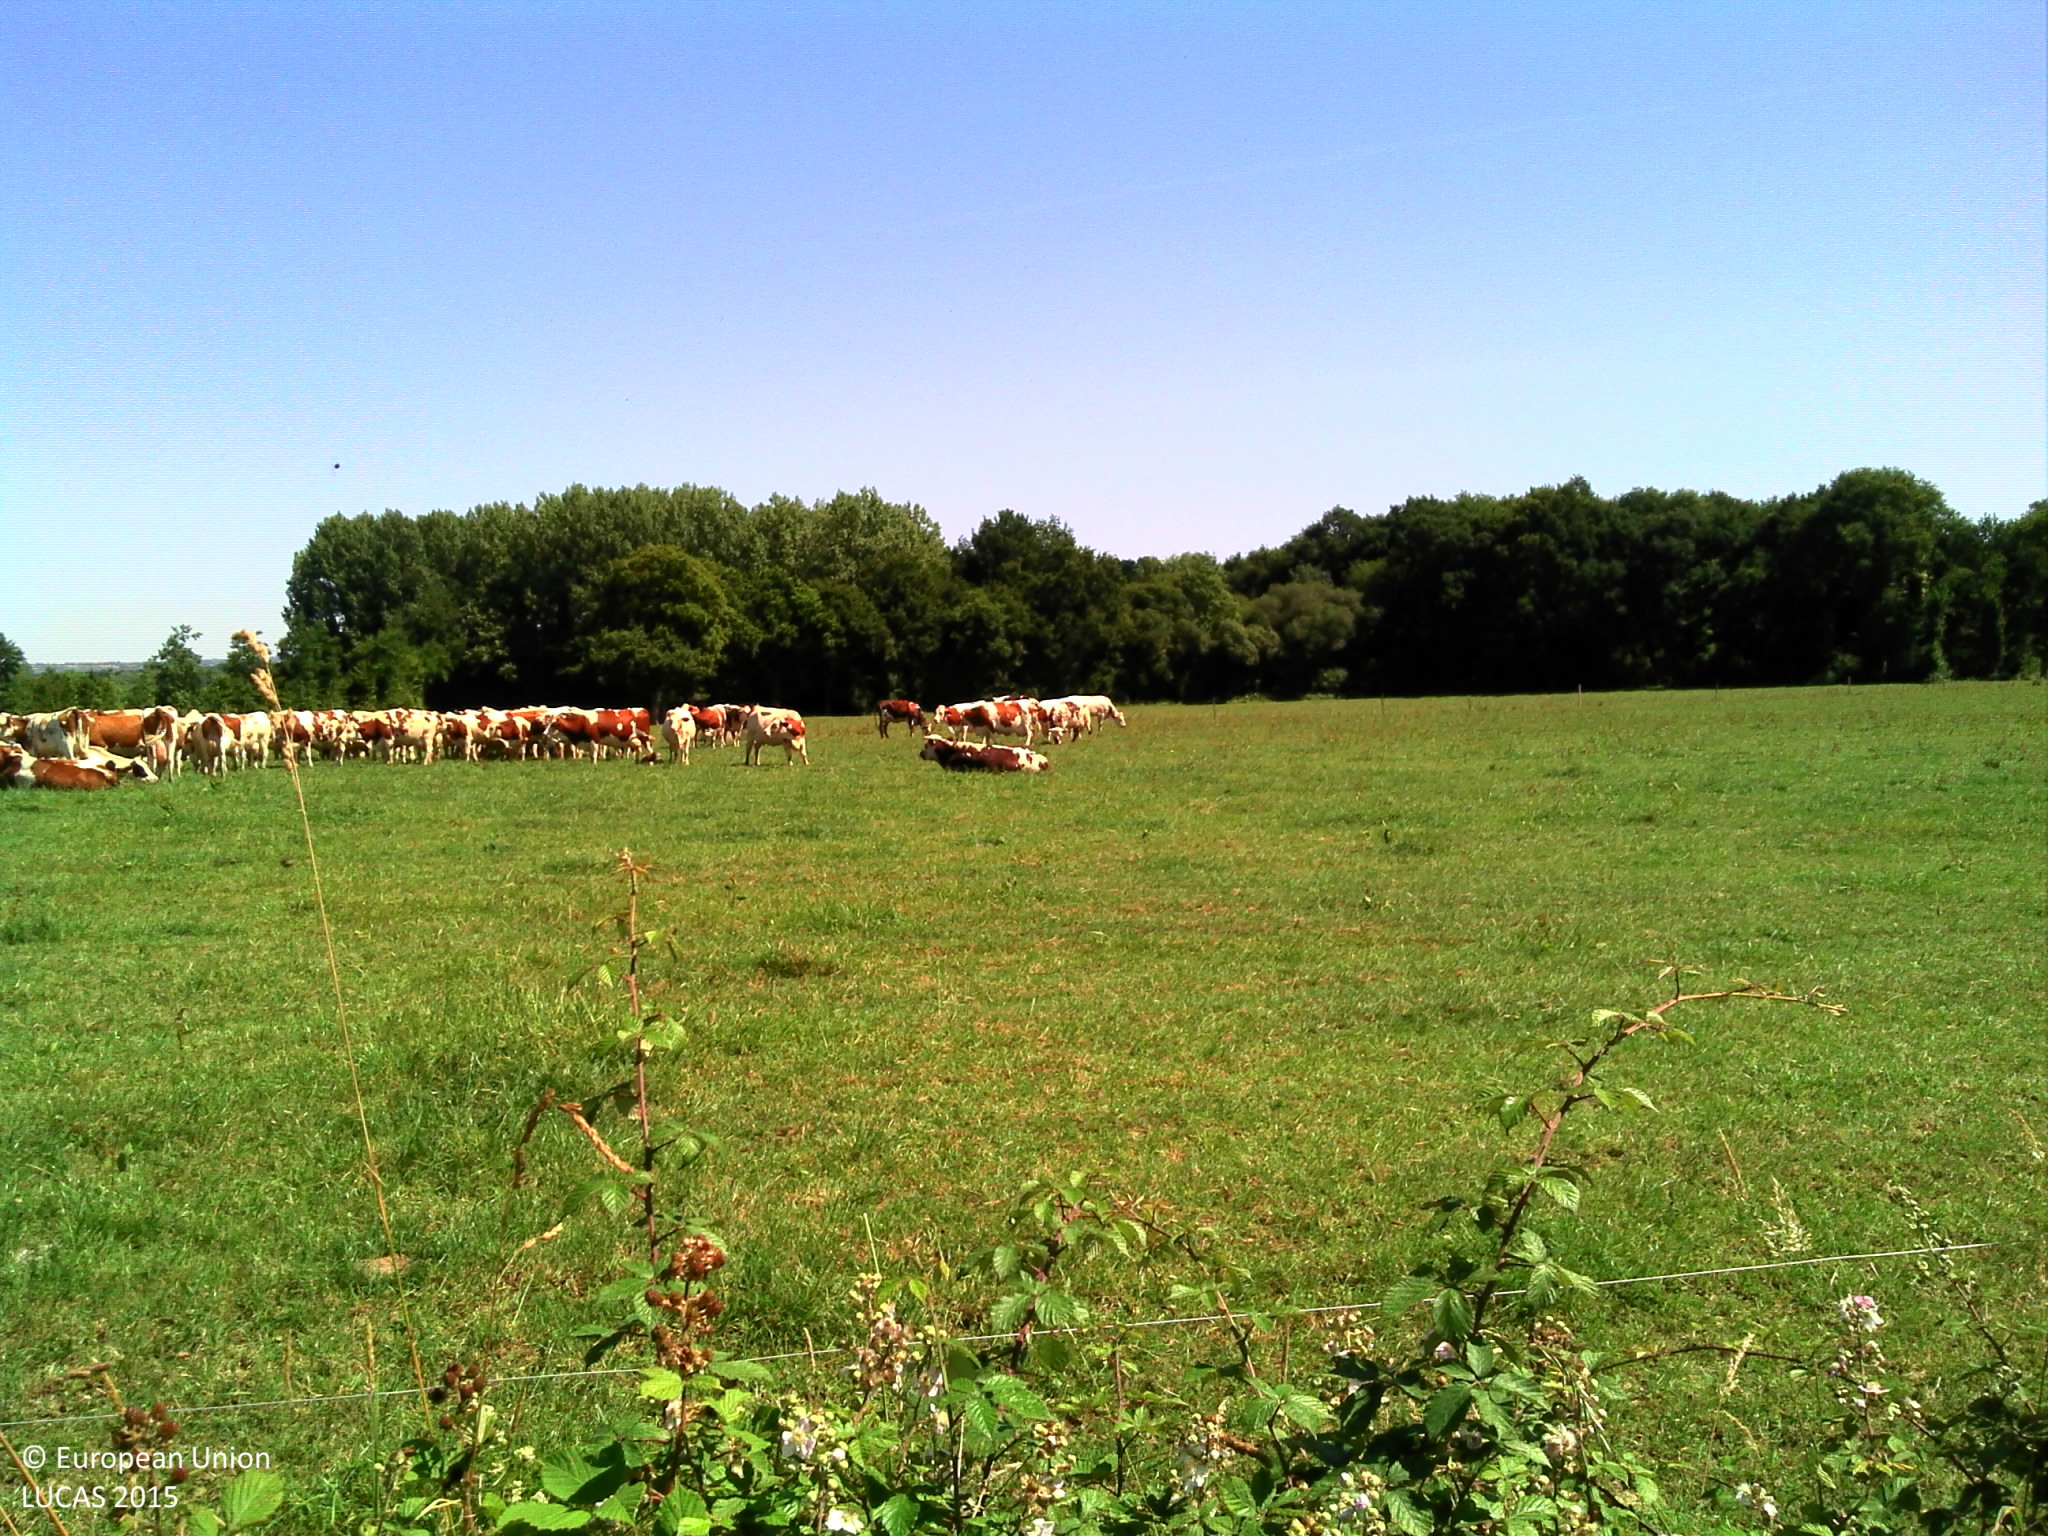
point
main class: Grassland
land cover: Grassland without tree/shrub cover
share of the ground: > 75 %
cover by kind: herbaceous plants 85 %, unconsolidated bare surface 15 %
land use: Agriculture (excluding fallow land and kitchen gardens)
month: July
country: FR
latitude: 48.3511
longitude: -2.1328
